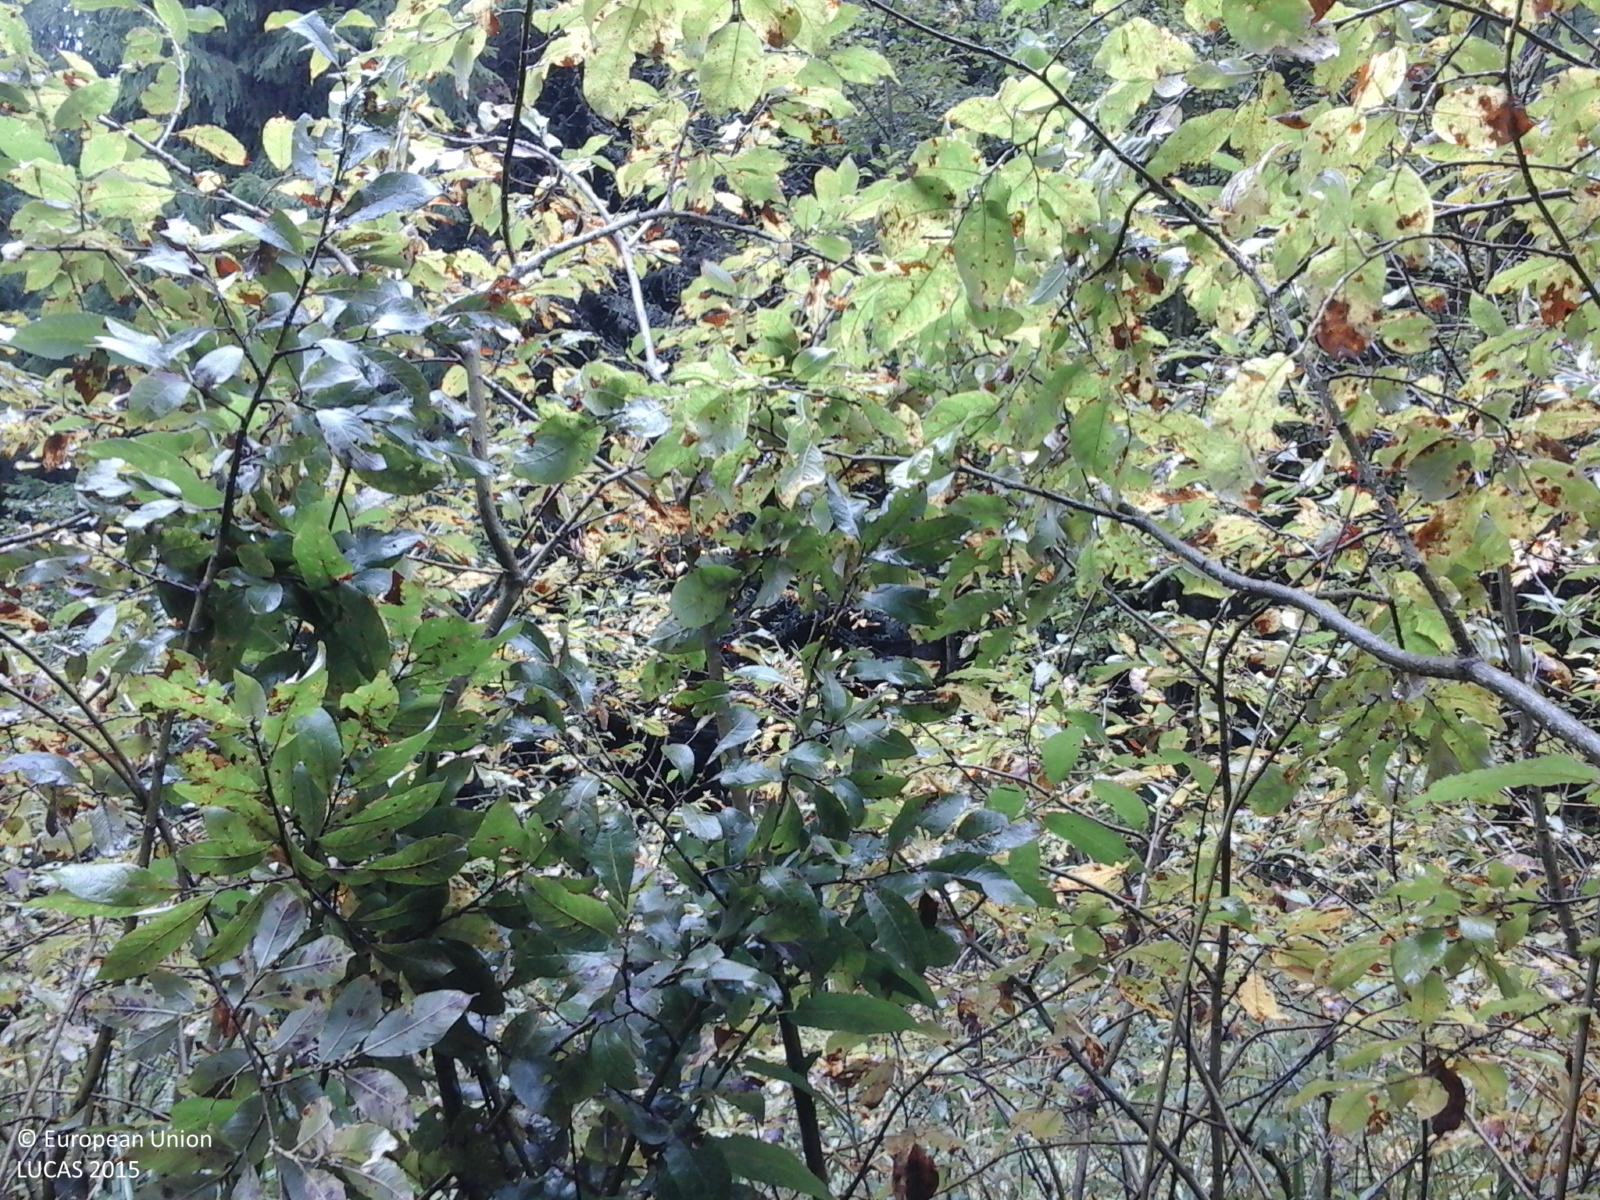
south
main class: Woodland
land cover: Spruce dominated coniferous woodland
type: alpine coniferous forest
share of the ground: > 75 %
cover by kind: coniferous forest trees 90 %, shrubs 5 %, herbaceous plants 5 %
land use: Forestry
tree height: > 5 m
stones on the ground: 10 - 25 %
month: September
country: RO
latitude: 45.5858
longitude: 23.6112
